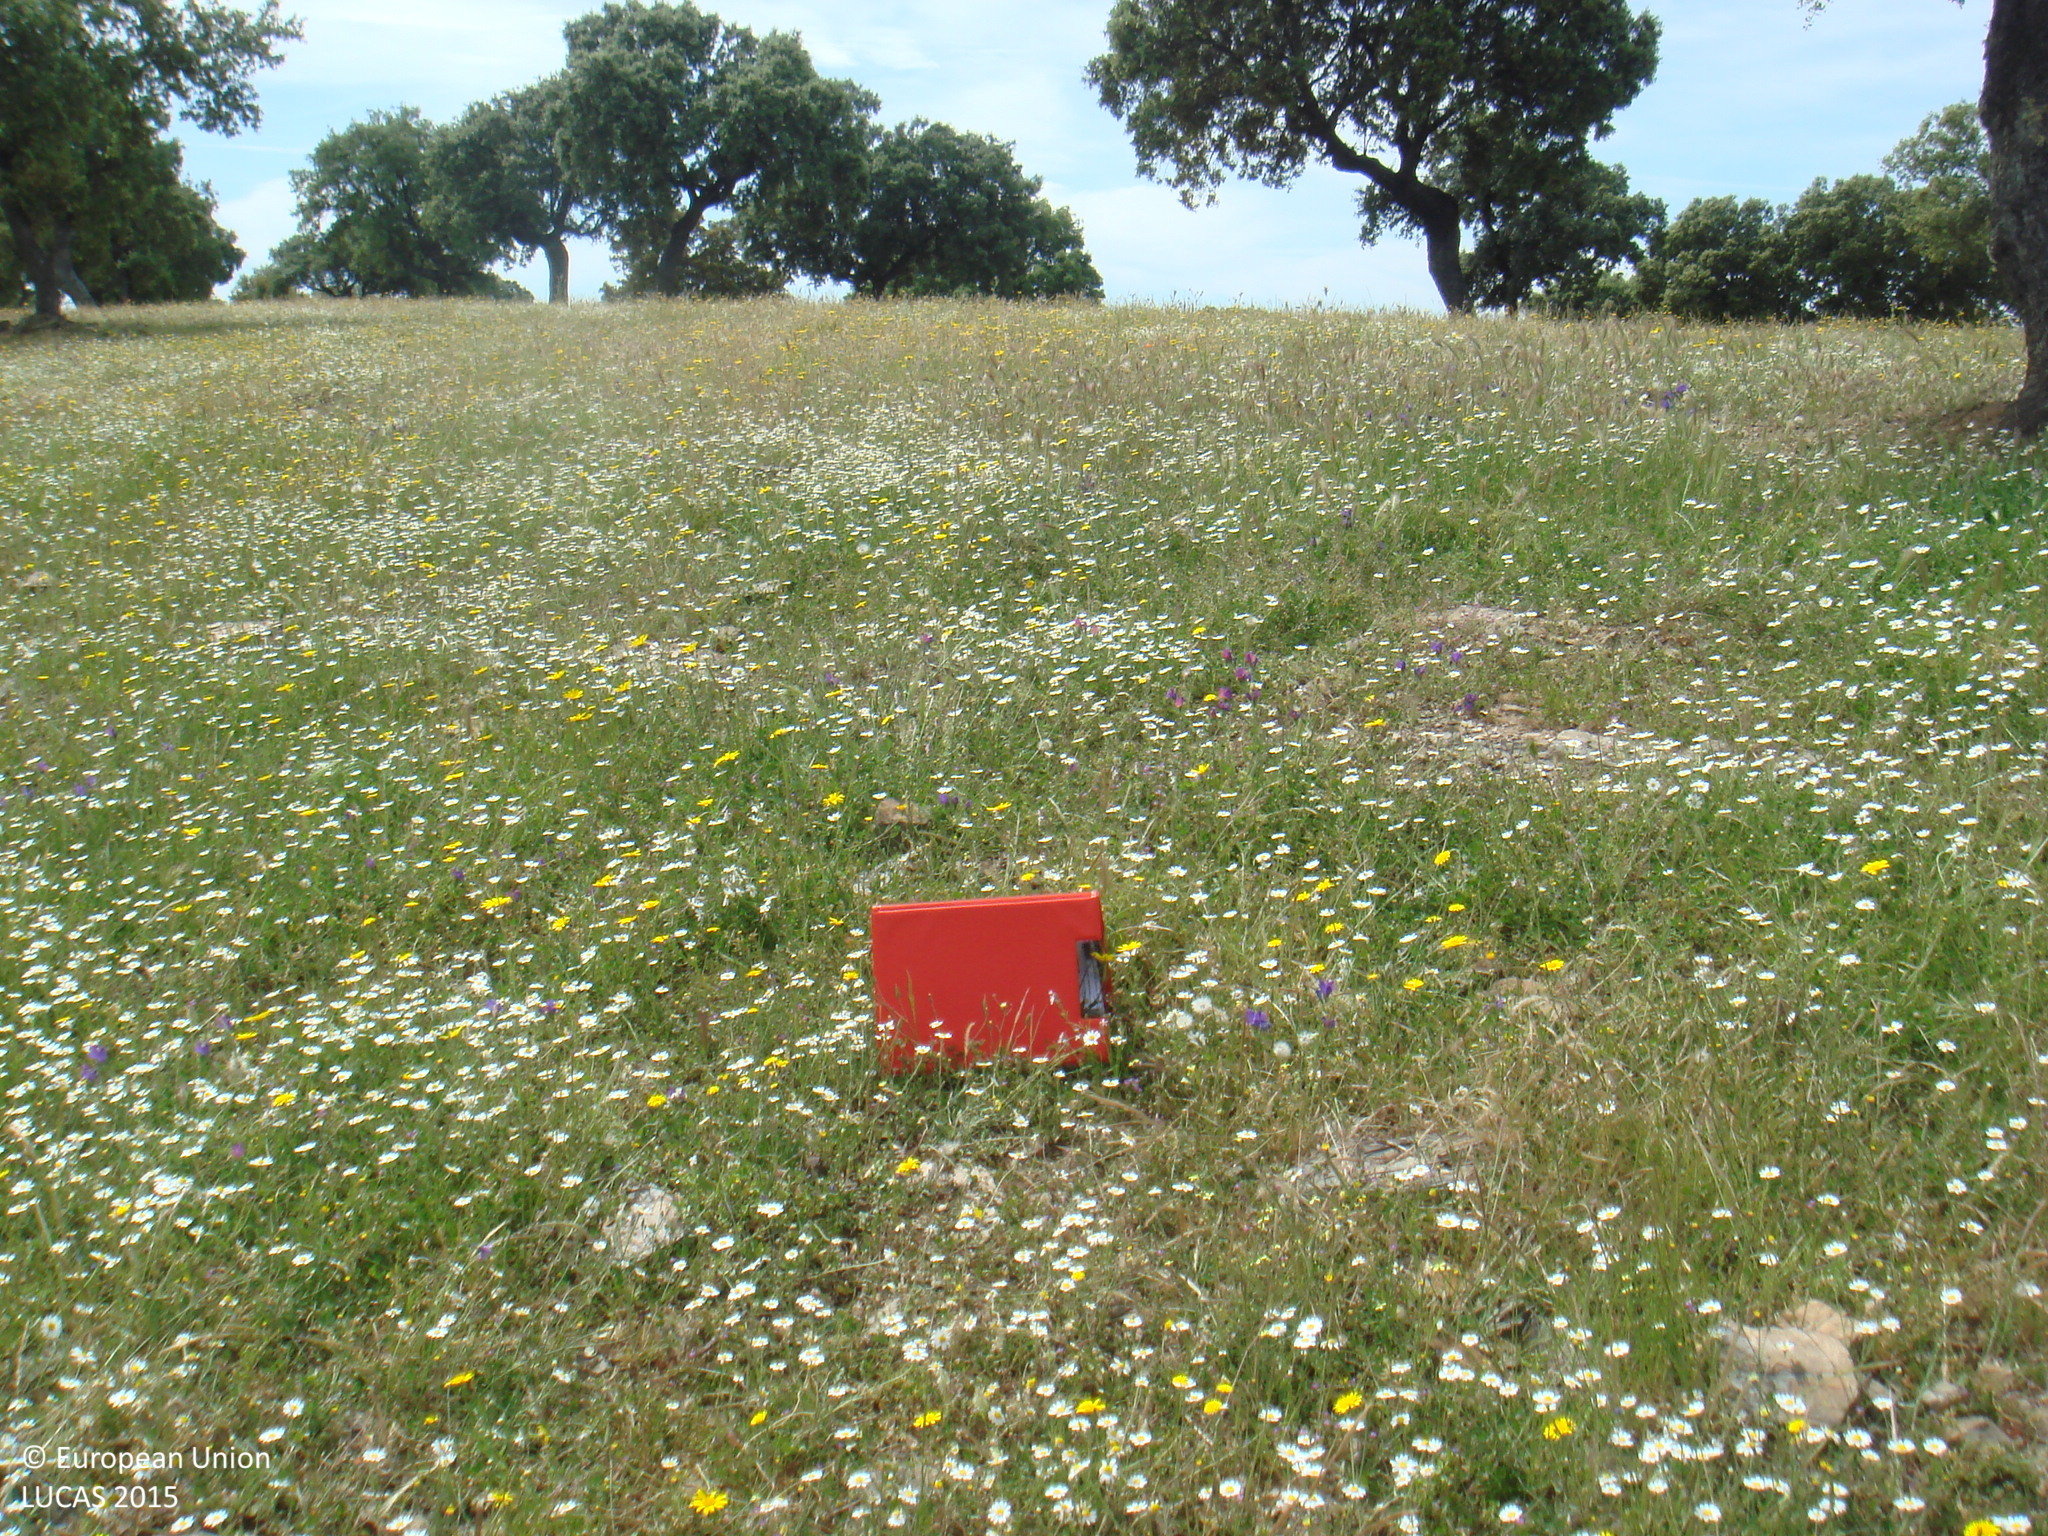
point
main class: Woodland
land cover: Broadleaved woodland
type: broadleaved evergreen forest
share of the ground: 25 - 50 %
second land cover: Grassland without tree/shrub cover
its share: > 75 %
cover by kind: herbaceous plants 70 %, broadleaved forest trees 30 %
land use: Forestry
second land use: Agriculture (excluding fallow land and kitchen gardens)
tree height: > 5 m
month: May
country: ES
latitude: 38.3775
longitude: -5.0796
